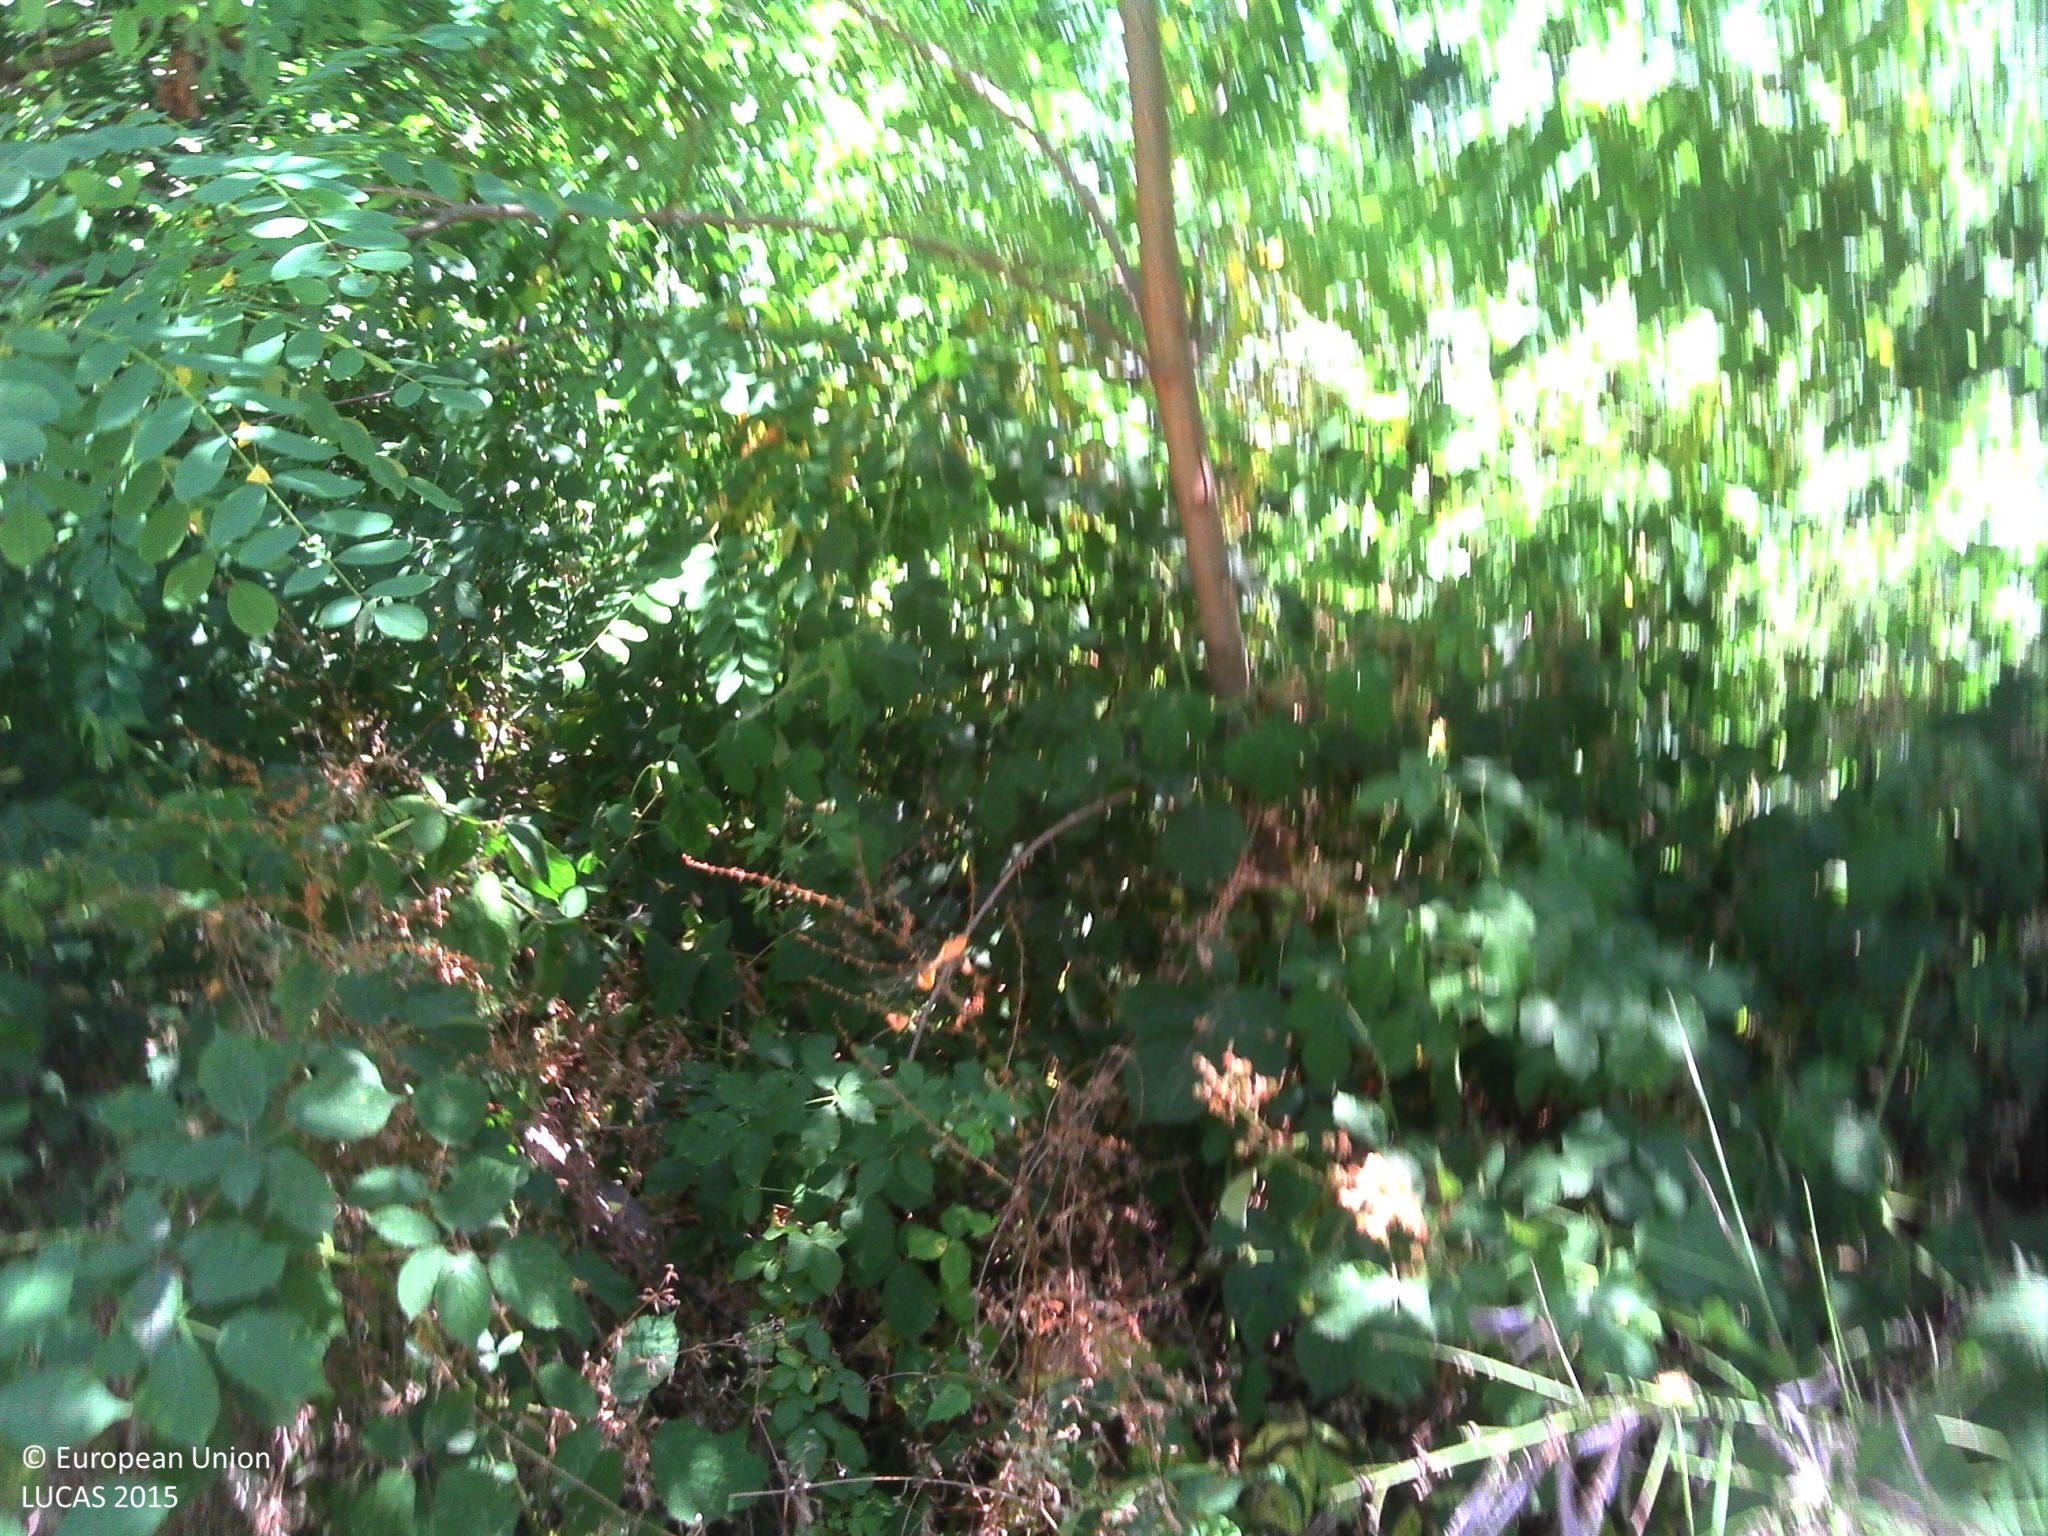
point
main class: Woodland
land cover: Broadleaved woodland
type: mesophytic deciduous forest
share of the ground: > 75 %
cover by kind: broadleaved forest trees 100 %
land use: Forestry
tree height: > 5 m
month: July
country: FR
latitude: 45.1598
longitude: 5.1839
